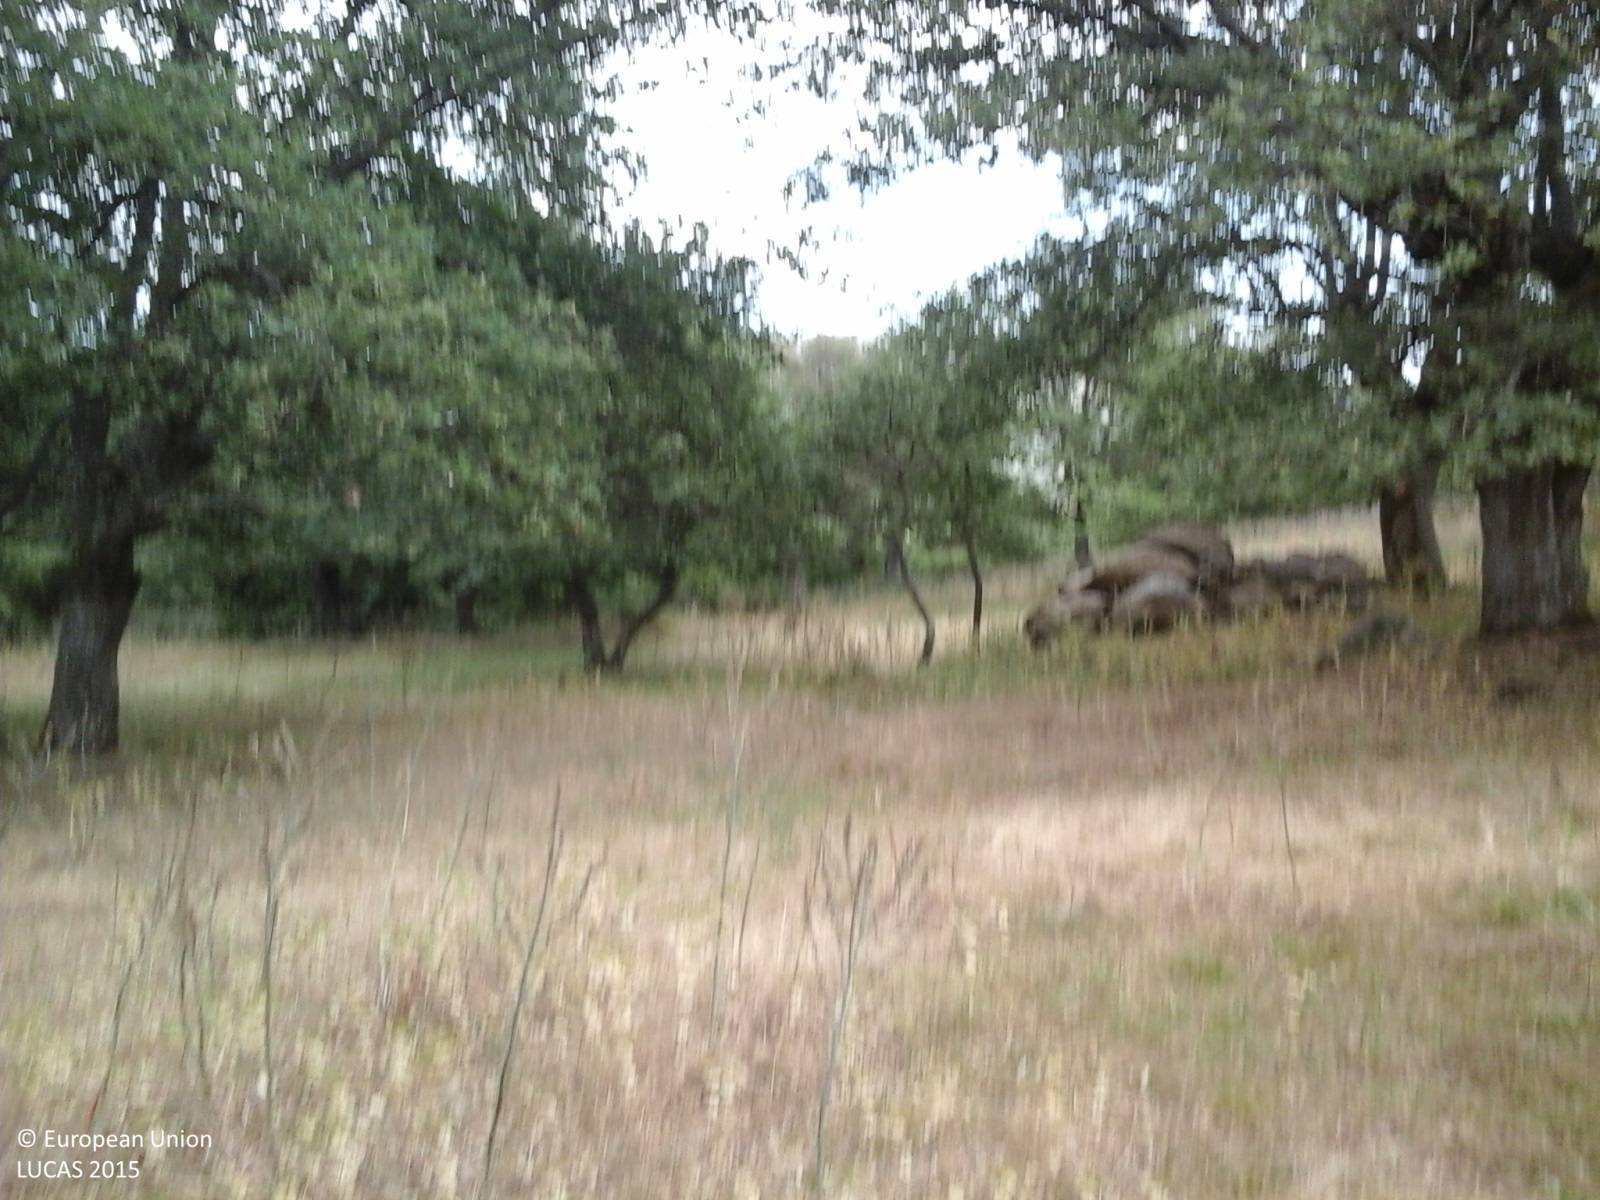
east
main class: Woodland
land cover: Broadleaved woodland
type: broadleaved evergreen forest
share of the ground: > 75 %
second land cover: Grassland without tree/shrub cover
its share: > 75 %
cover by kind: broadleaved forest trees 80 %, herbaceous plants 20 %
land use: Forestry
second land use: Agriculture (excluding fallow land and kitchen gardens)
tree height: > 5 m
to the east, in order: Broadleaved woodland; Grassland without tree/shrub cover; Dry stone walls; Paved roads, cycling and walking lanes; Fences; Shrubland with sparse tree cover; Broadleaved woodland; Fences; Grassland without tree/shrub cover; Broadleaved woodland; Abandoned hedges; Fences; Broadleaved woodland; Grassland with sparse tree/shrub cover; Fences; Tracks; Broadleaved woodland
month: June
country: IT
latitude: 40.4991
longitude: 9.1664
